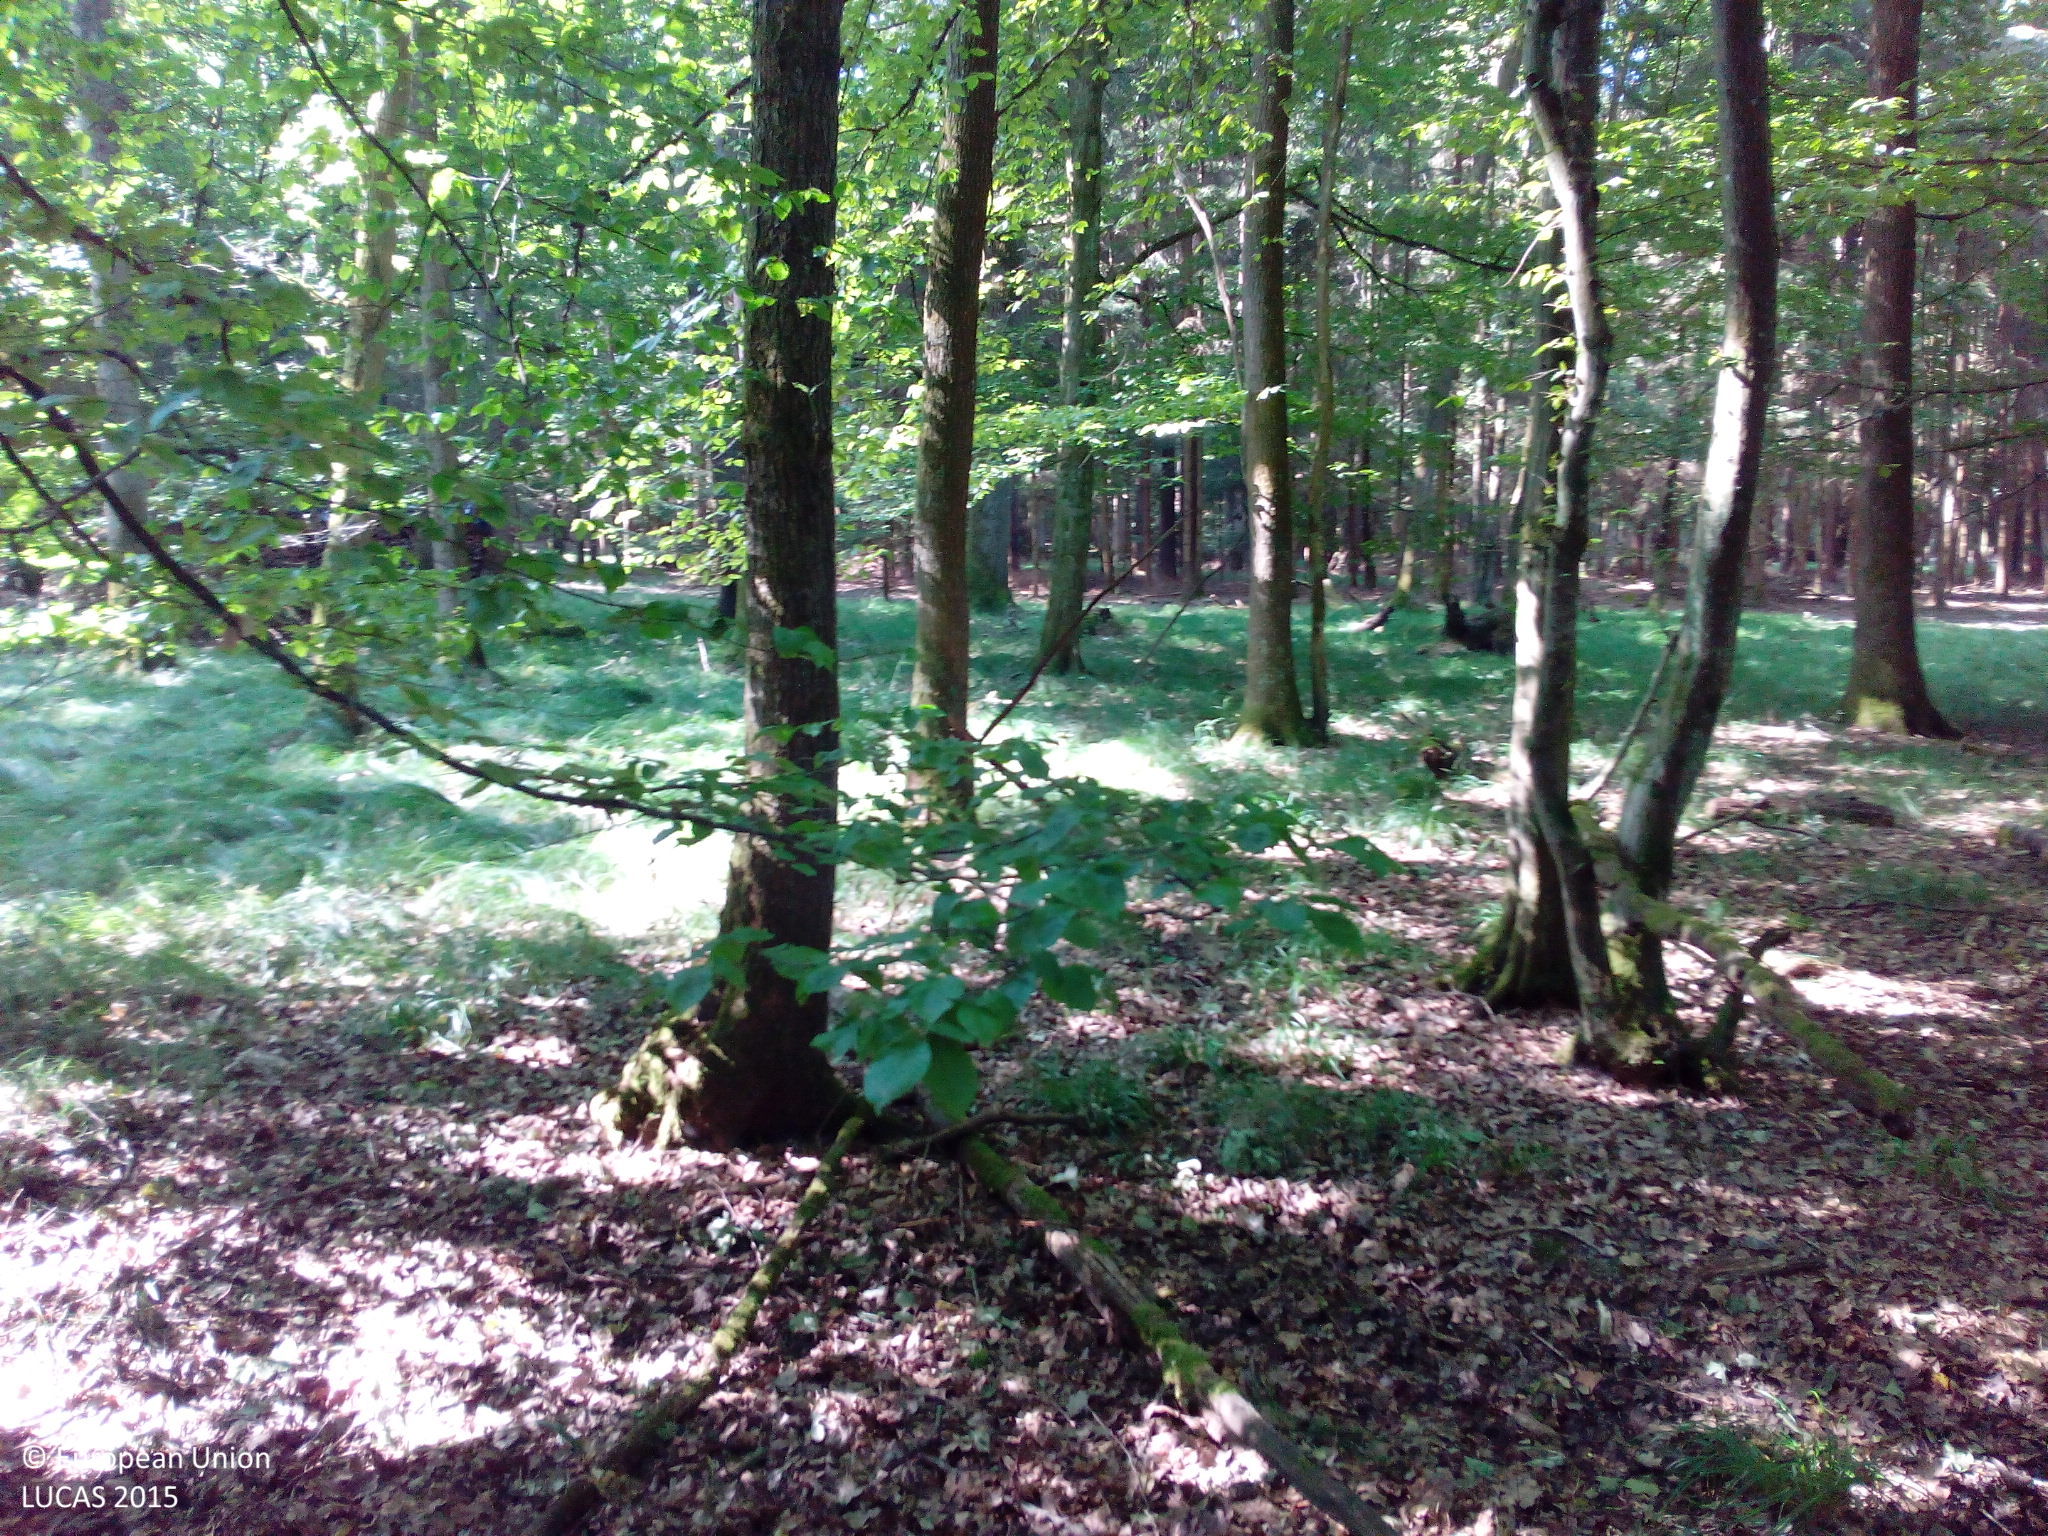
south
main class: Woodland
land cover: Broadleaved woodland
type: mesophytic deciduous forest
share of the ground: > 75 %
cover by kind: broadleaved forest trees 95 %, lichens and mosses 5 %
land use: Forestry
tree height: > 5 m
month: July
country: DE
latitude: 49.7476
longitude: 11.0683
